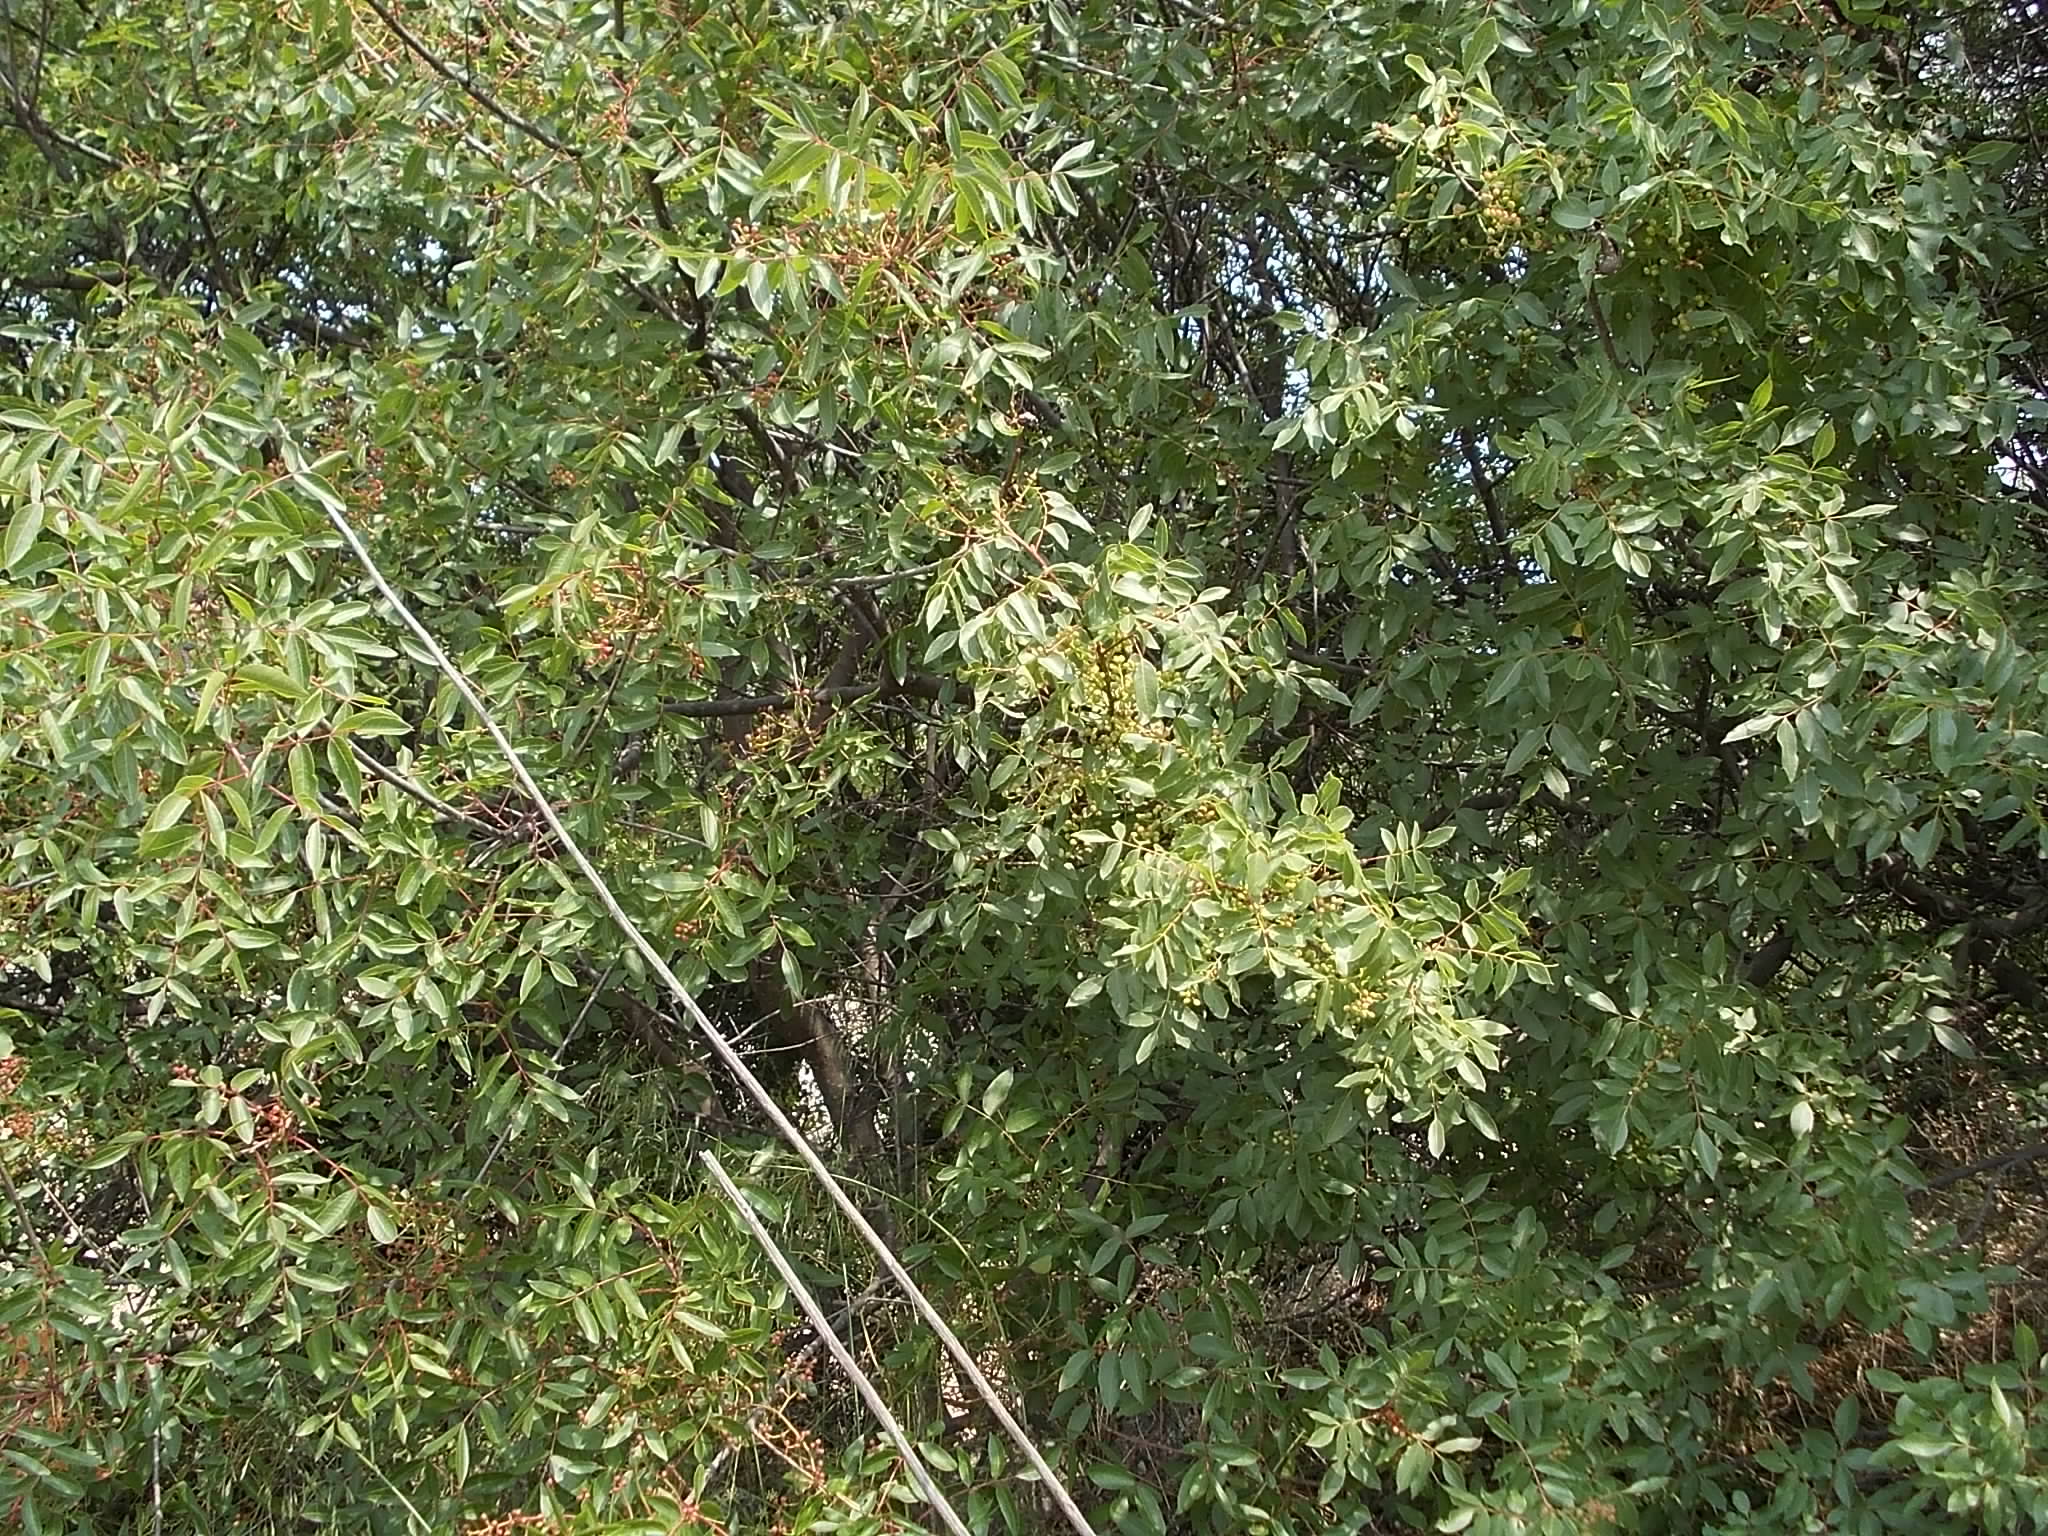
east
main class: Grassland
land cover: Grassland with sparse tree/shrub cover
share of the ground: > 75 %
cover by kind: herbaceous plants 95 %, broadleaved forest trees 5 %
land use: Semi-natural and natural areas not in use
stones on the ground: 10 - 25 %
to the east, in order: Grassland with sparse tree/shrub cover; Nuts trees; Grass margins; Nuts trees; Grass margins; Nuts trees; Paved roads, cycling and walking lanes; Grassland without tree/shrub cover; Vineyards; Grassland without tree/shrub cover; Vineyards
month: June
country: CY
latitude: 34.8278
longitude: 32.9411
